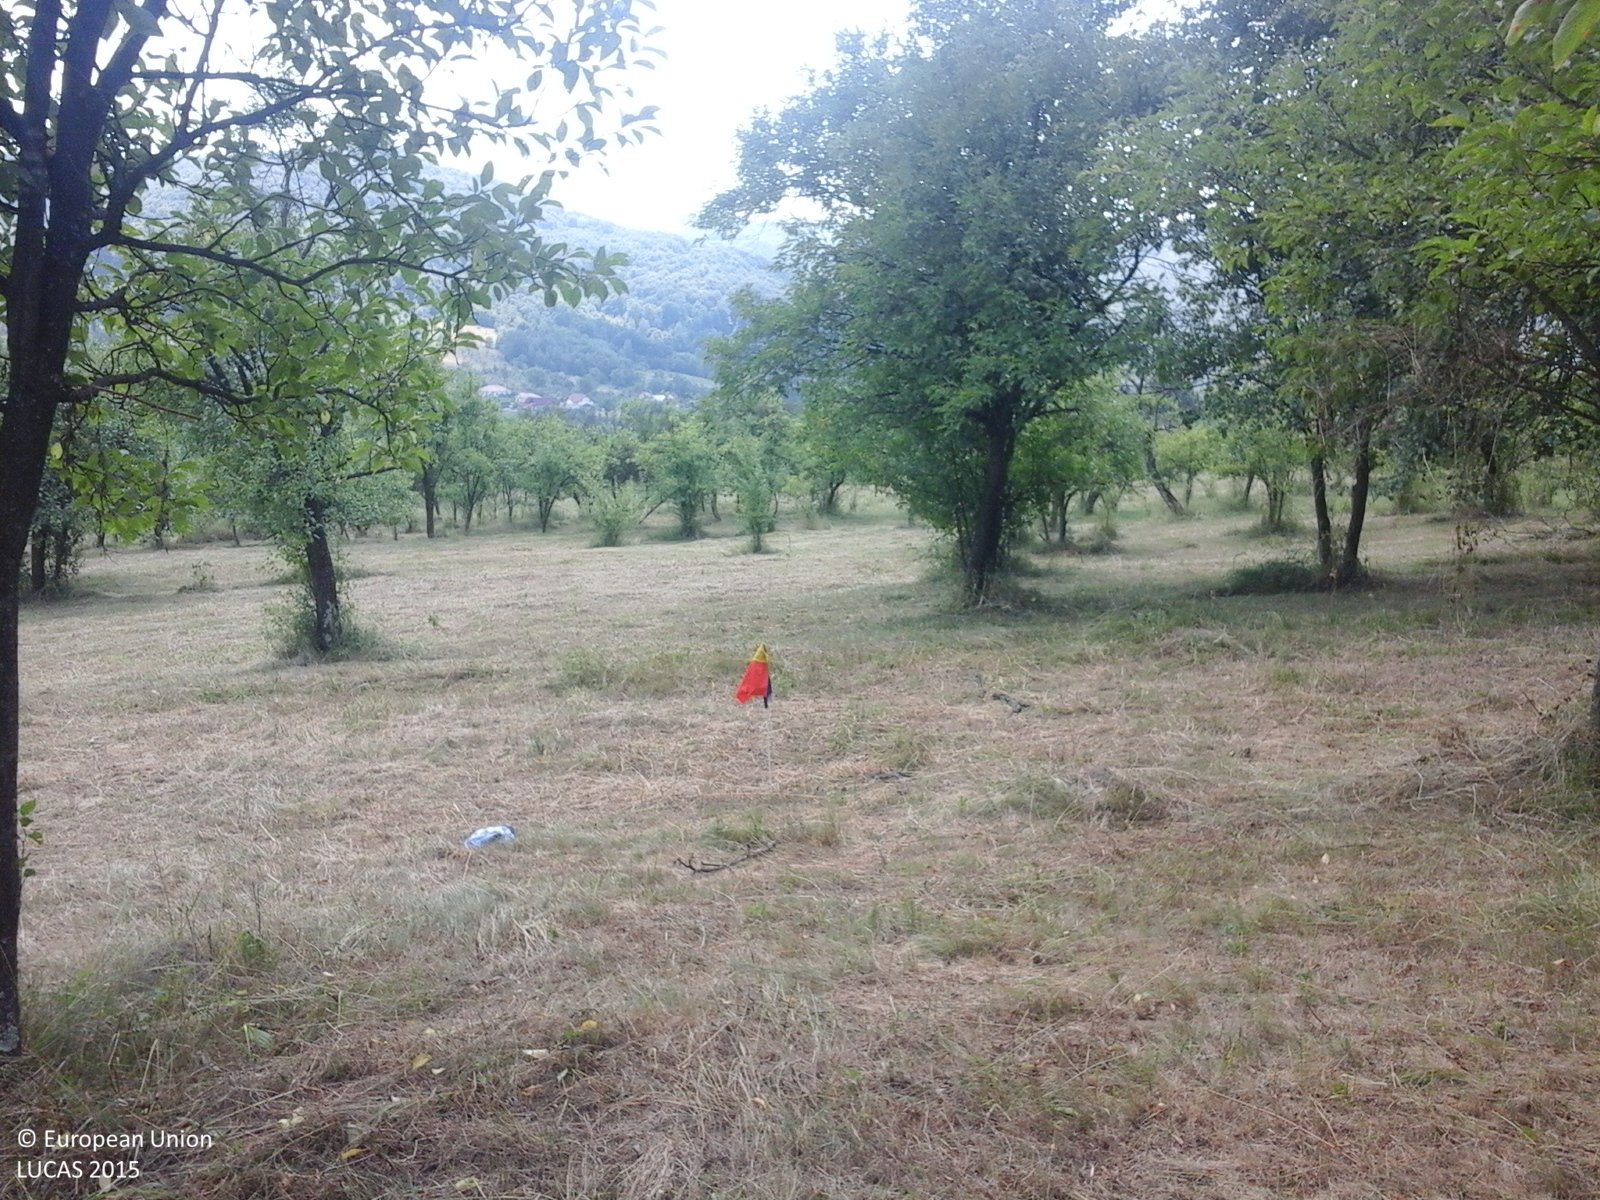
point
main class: Cropland
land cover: Other fruit trees and berries
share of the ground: 25 - 50 %
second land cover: Grassland without tree/shrub cover
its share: > 75 %
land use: Agriculture (excluding fallow land and kitchen gardens)
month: July
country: RO
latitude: 45.0723
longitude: 24.4407
